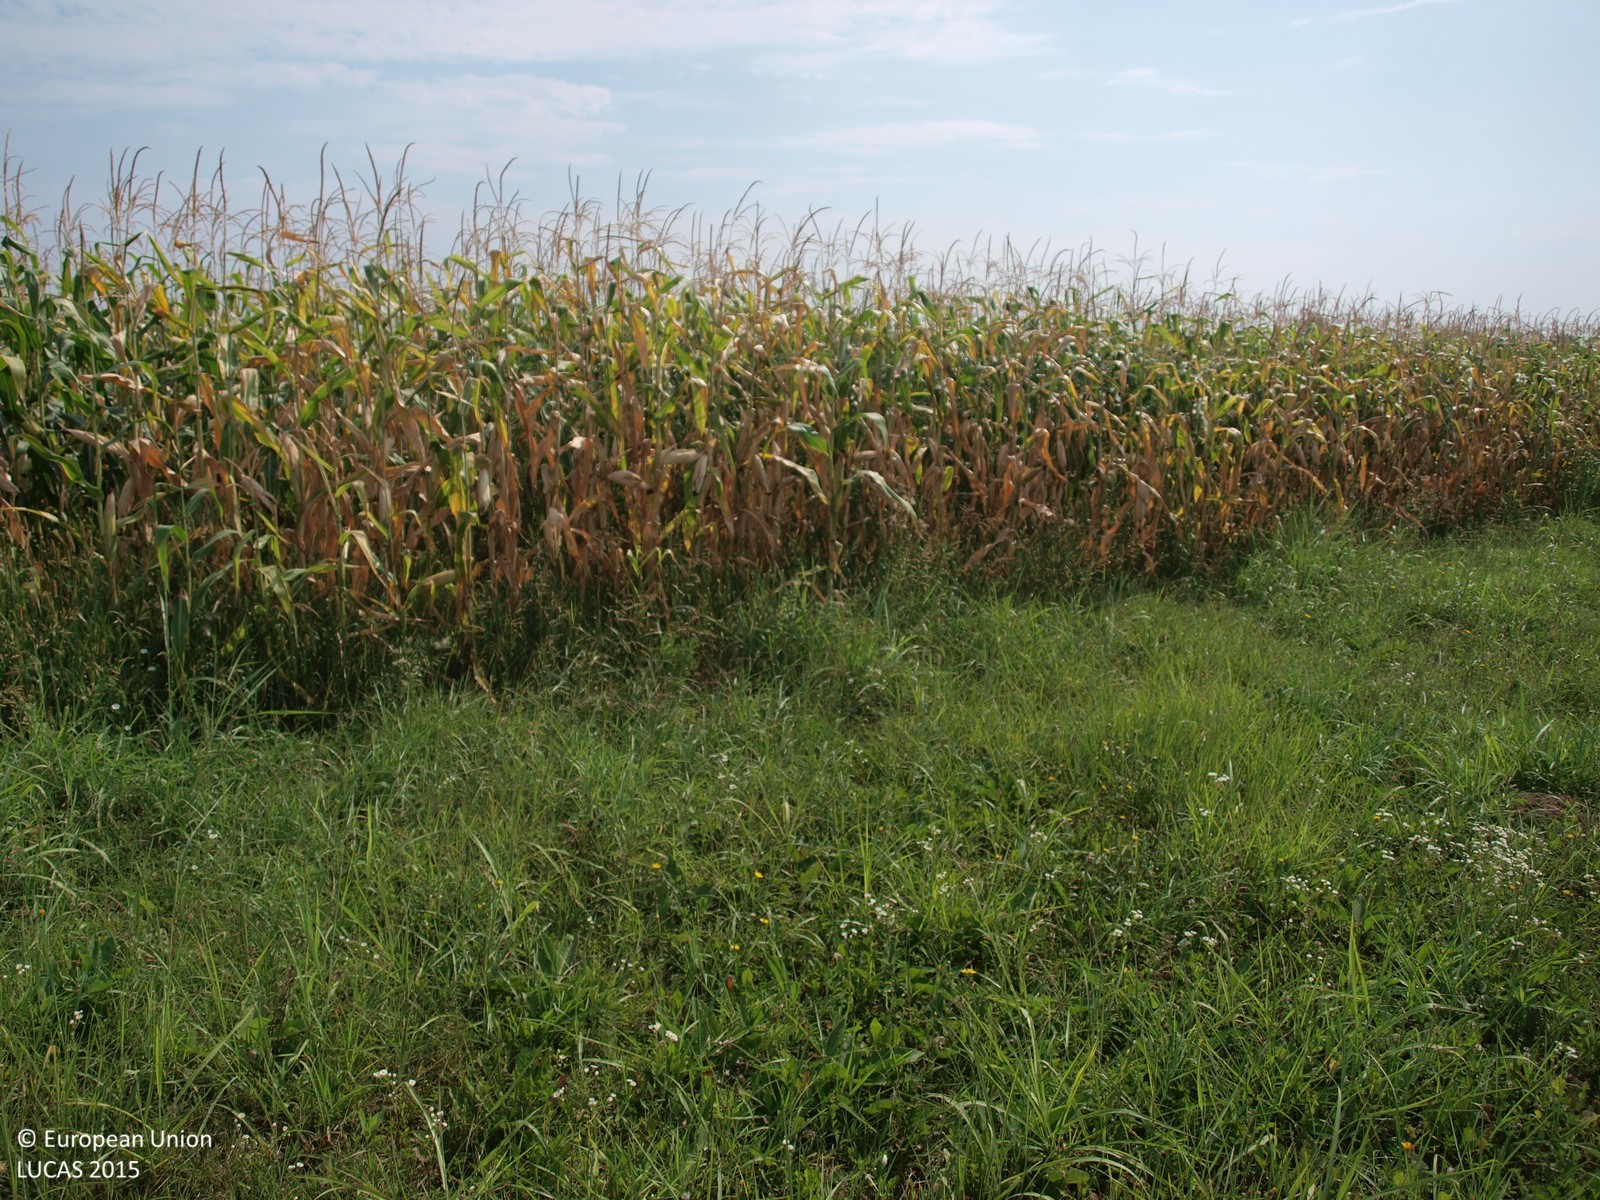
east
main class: Grassland
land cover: Grassland without tree/shrub cover
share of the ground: > 75 %
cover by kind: herbaceous plants 100 %
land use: Agriculture (excluding fallow land and kitchen gardens)
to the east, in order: Grassland without tree/shrub cover; Maize; Grassland without tree/shrub cover; Maize; Common wheat; Grass margins; Rivers and streams; Grass margins; Maize
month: August
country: HR
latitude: 45.7758
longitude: 15.8491
